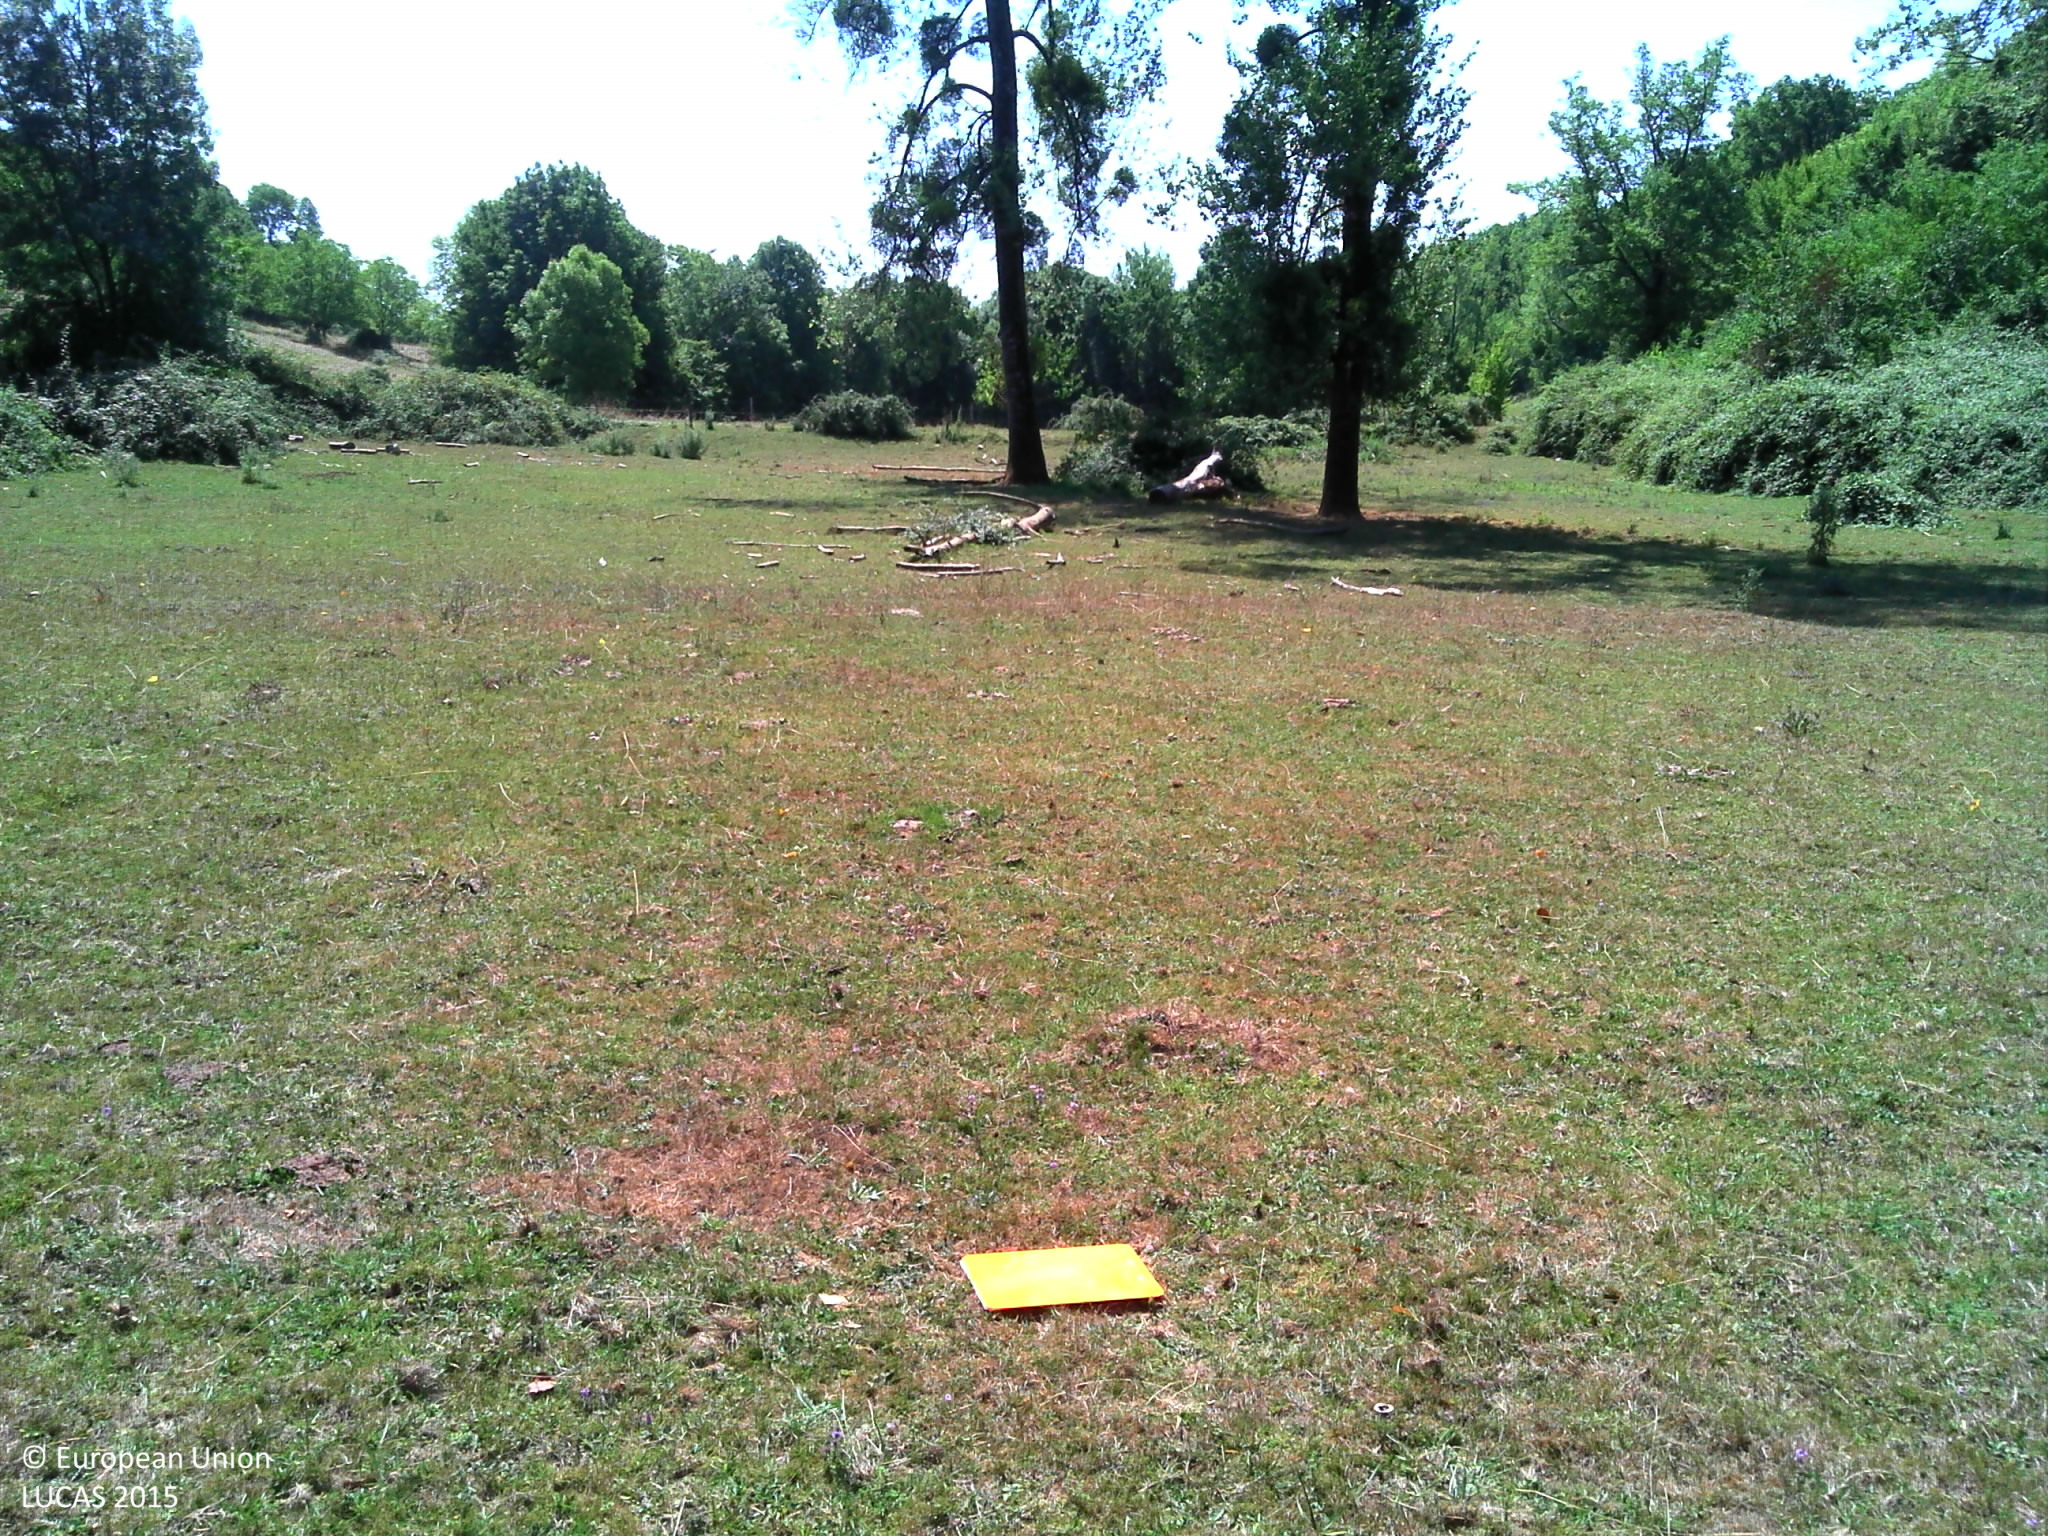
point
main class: Grassland
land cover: Grassland without tree/shrub cover
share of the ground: > 75 %
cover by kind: herbaceous plants 100 %
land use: Agriculture (excluding fallow land and kitchen gardens)
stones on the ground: < 10 %
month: August
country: FR
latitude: 45.3586
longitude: 1.0427
